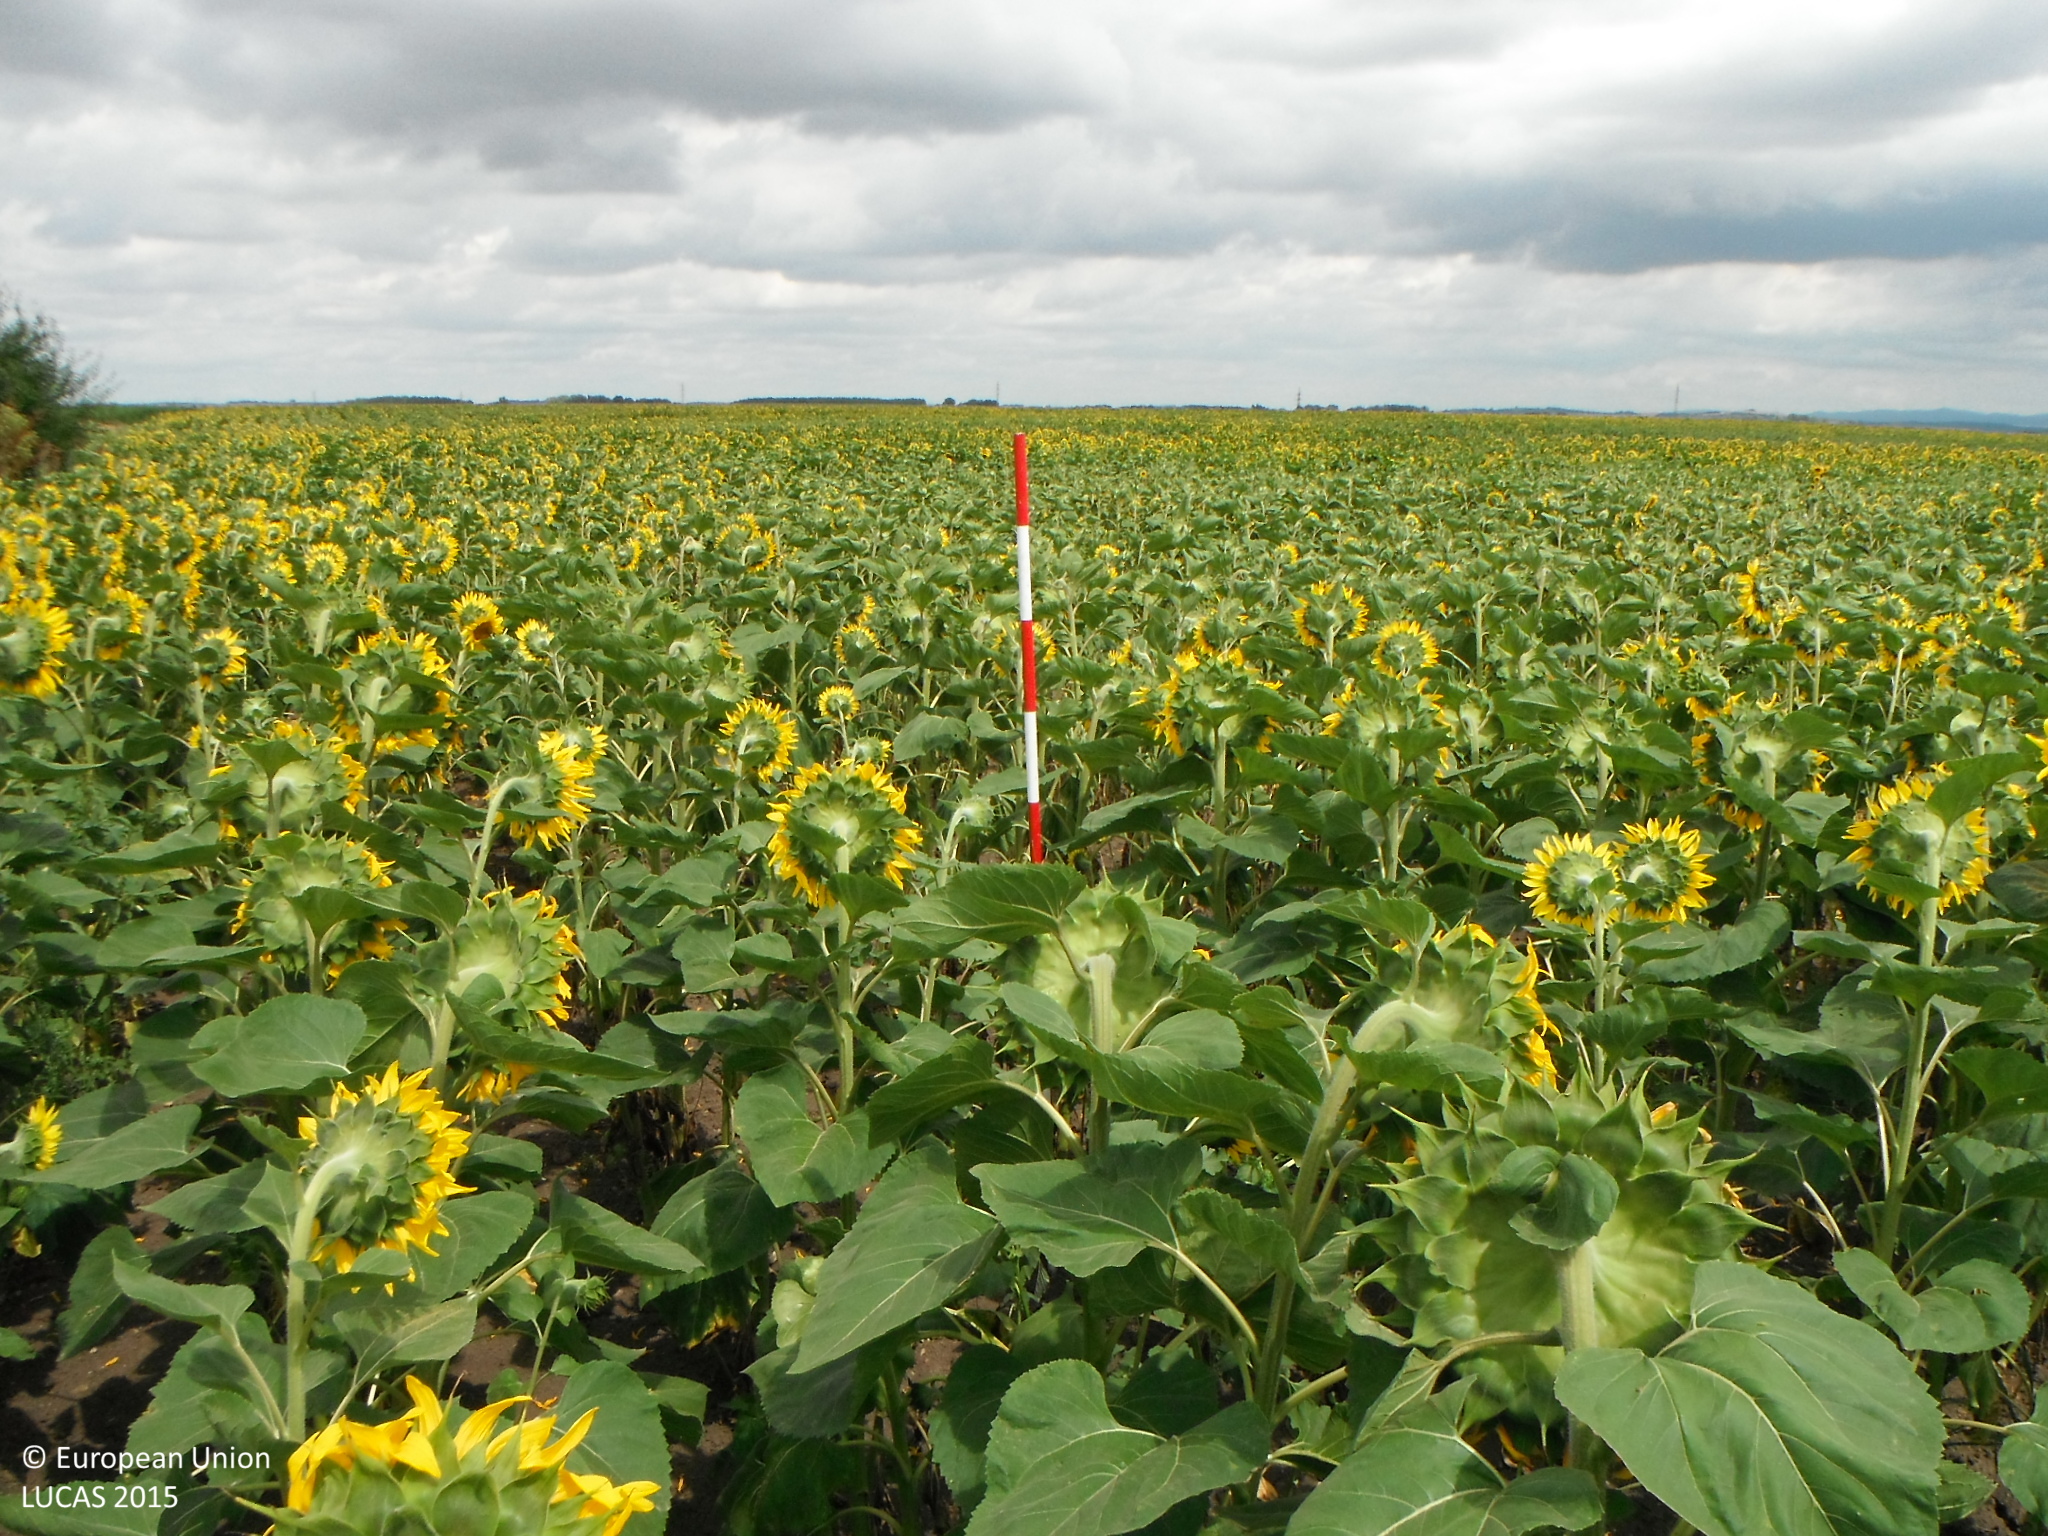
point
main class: Cropland
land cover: Sunflower
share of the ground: > 75 %
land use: Agriculture (excluding fallow land and kitchen gardens)
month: July
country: SK
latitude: 48.0844
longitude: 18.6217
